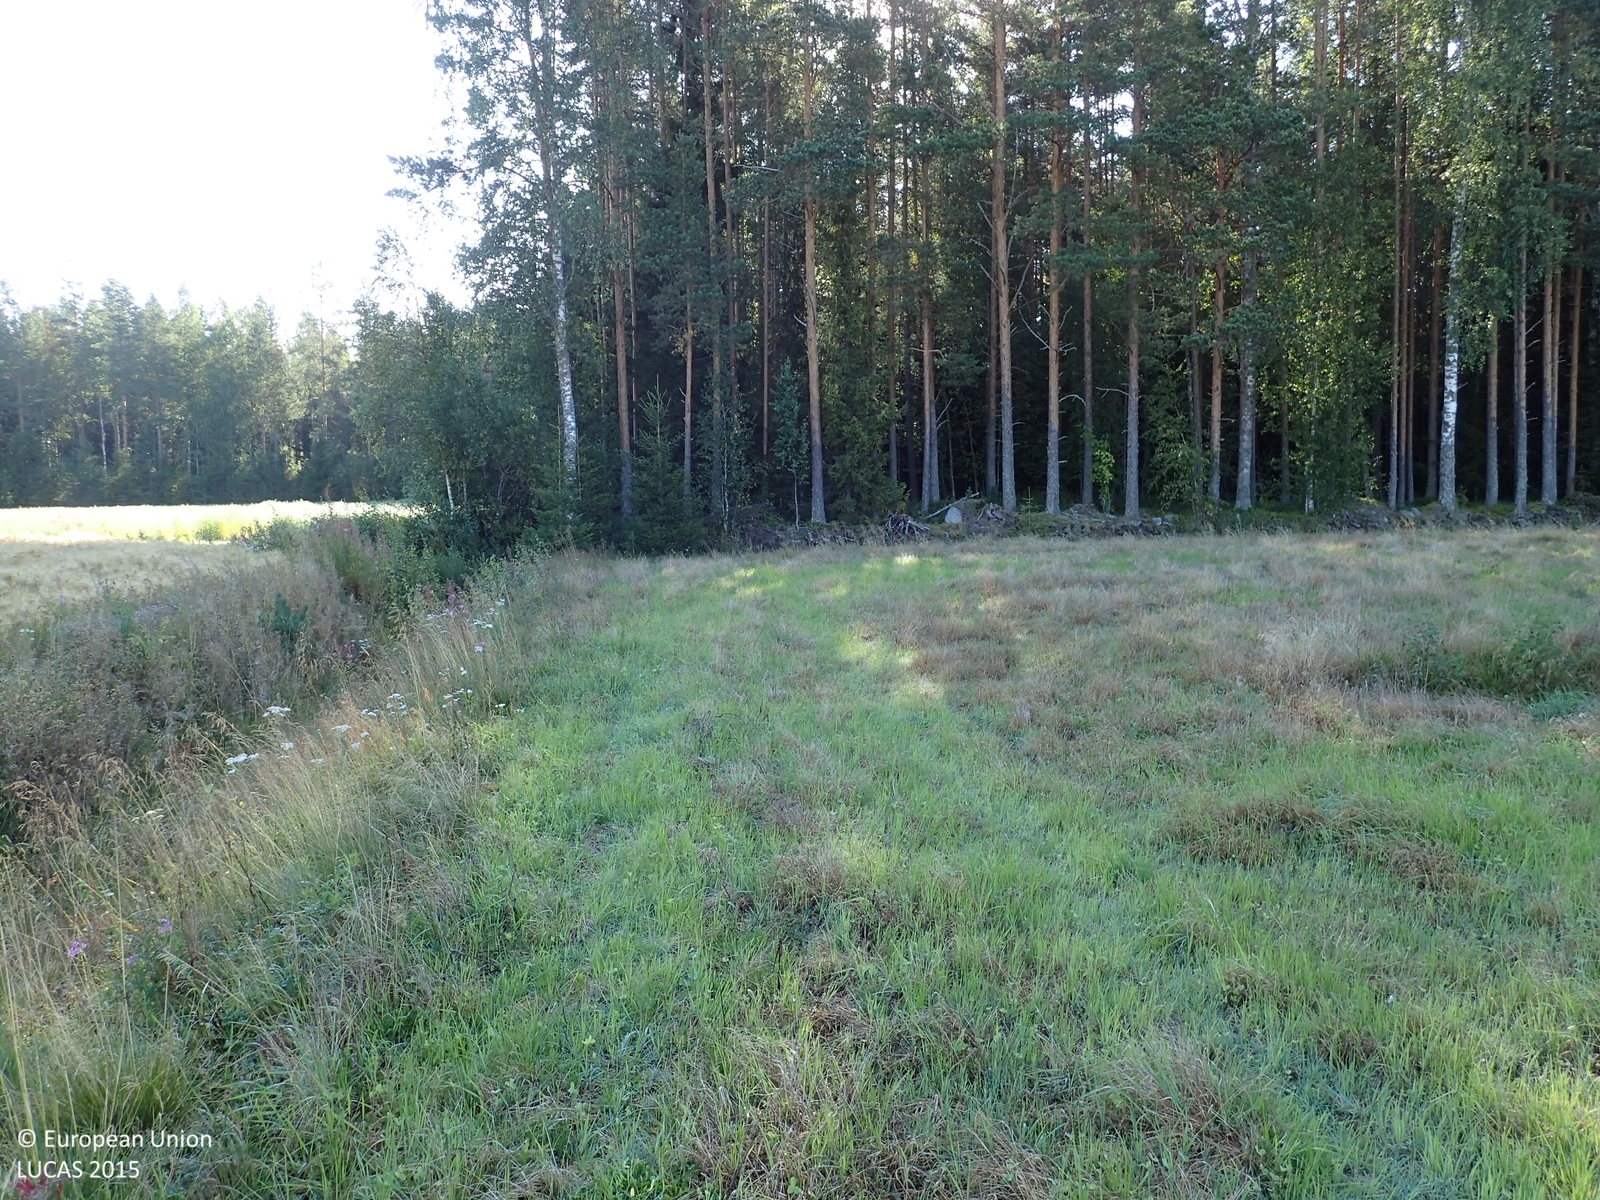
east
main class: Cropland
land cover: Temporary grasslands
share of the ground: > 75 %
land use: Agriculture (excluding fallow land and kitchen gardens)
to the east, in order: Temporary grasslands; Ditches and canals; Temporary grasslands; Ditches and canals; Pine dominated mixed woodland; Ditches and canals; Pine dominated mixed woodland; Ditches and canals; Pine dominated mixed woodland; Ditches and canals; Pine dominated mixed woodland; Ditches and canals; Pine dominated mixed woodland; Ditches and canals; Pine dominated mixed woodland; Ditches and canals; Pine dominated mixed woodland
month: August
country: FI
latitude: 62.4617
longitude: 21.9726
